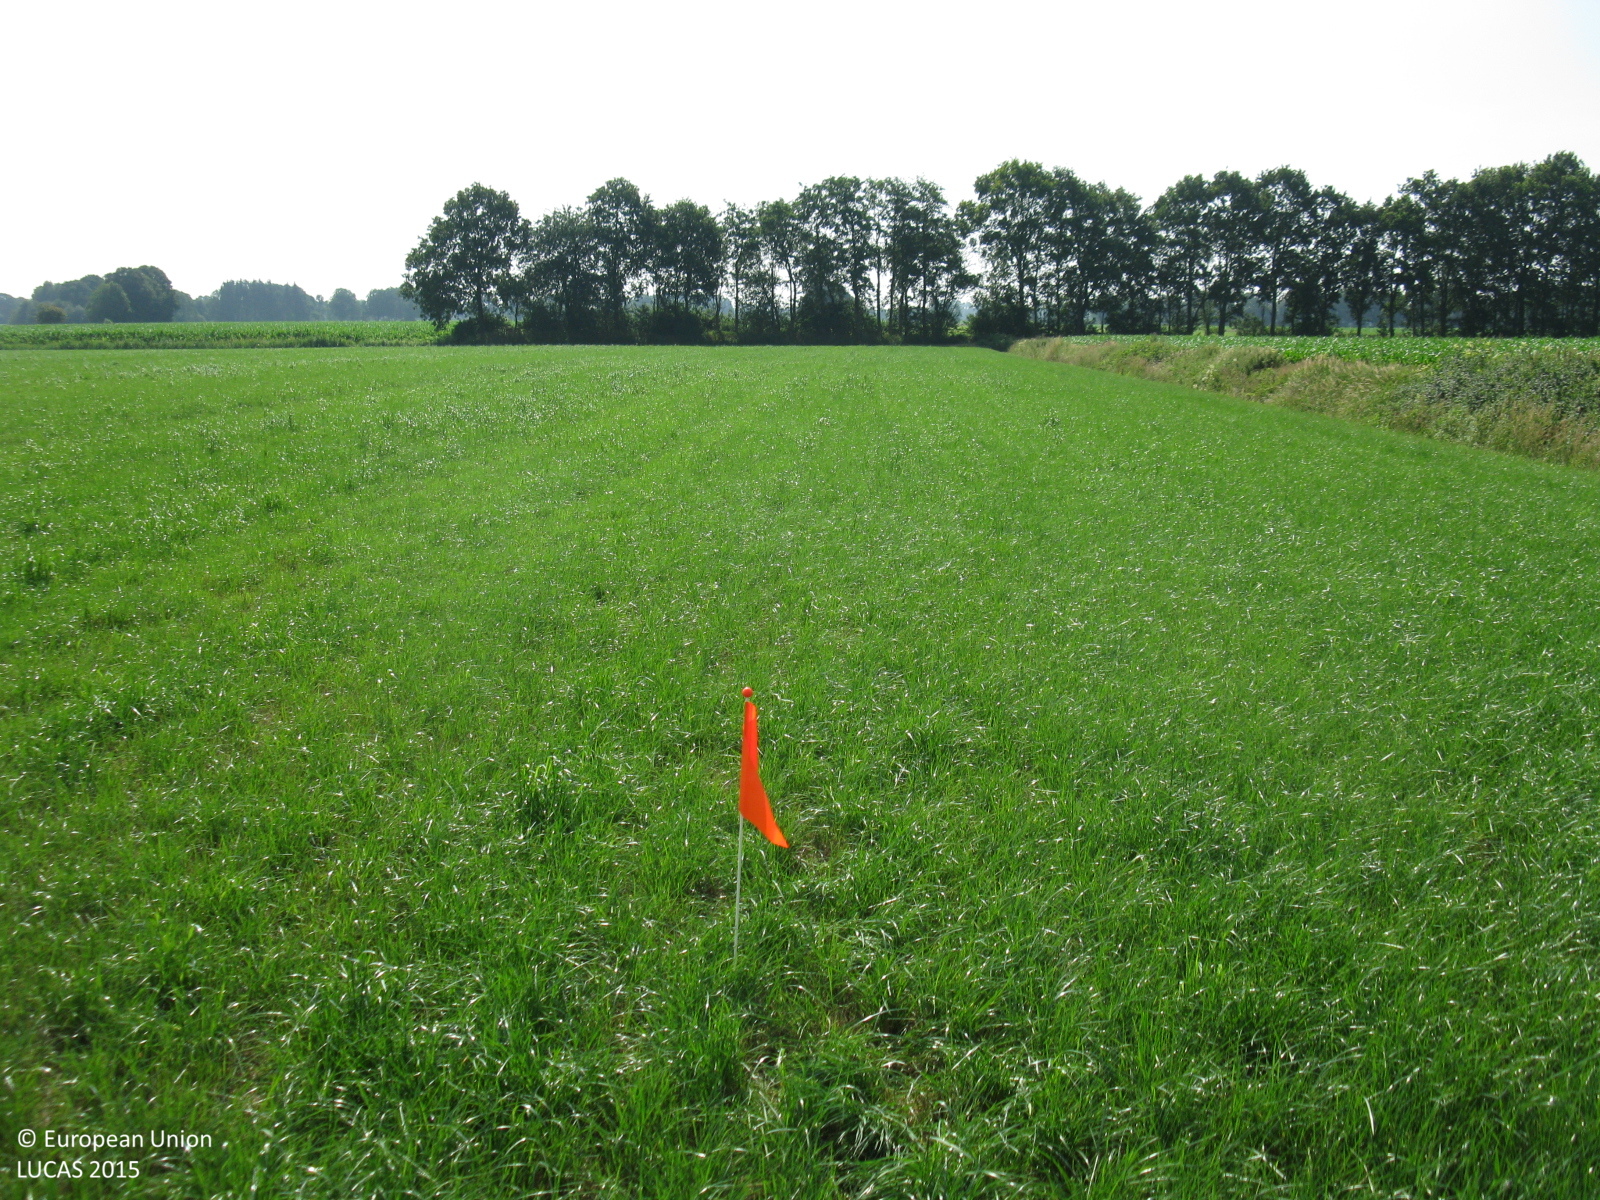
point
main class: Grassland
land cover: Grassland without tree/shrub cover
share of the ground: > 75 %
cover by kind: herbaceous plants 100 %
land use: Agriculture (excluding fallow land and kitchen gardens)
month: July
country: DE
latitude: 53.1858
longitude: 7.8906
